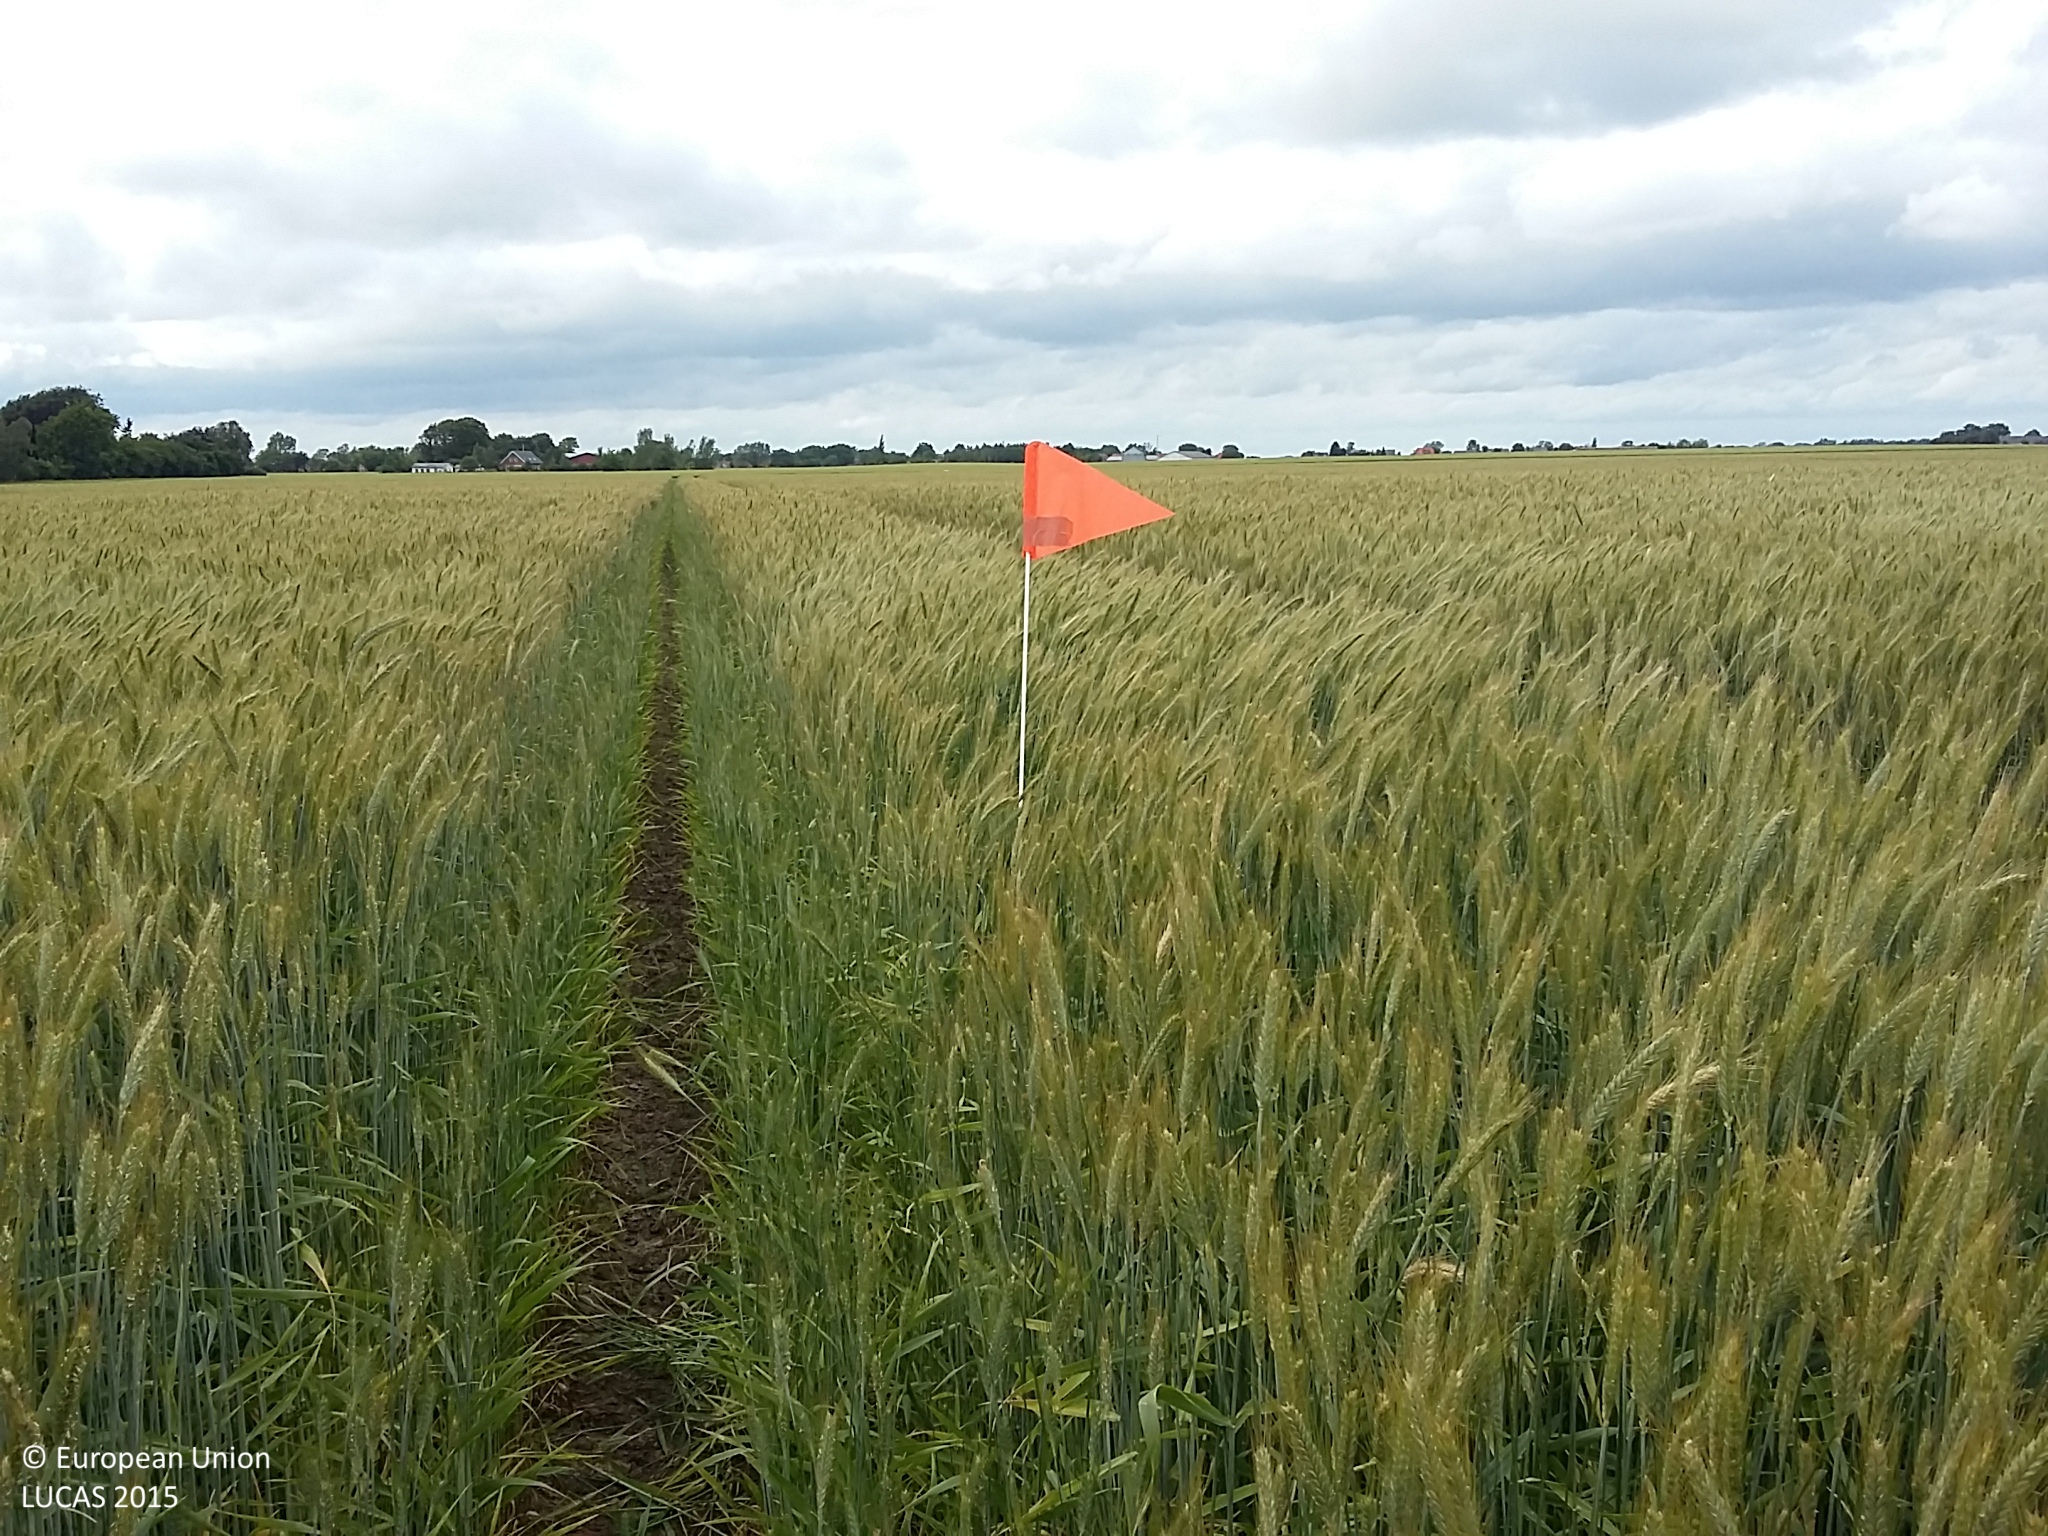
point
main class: Cropland
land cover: Rye
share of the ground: > 75 %
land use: Agriculture (excluding fallow land and kitchen gardens)
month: June
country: DK
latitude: 54.6853
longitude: 11.6277
